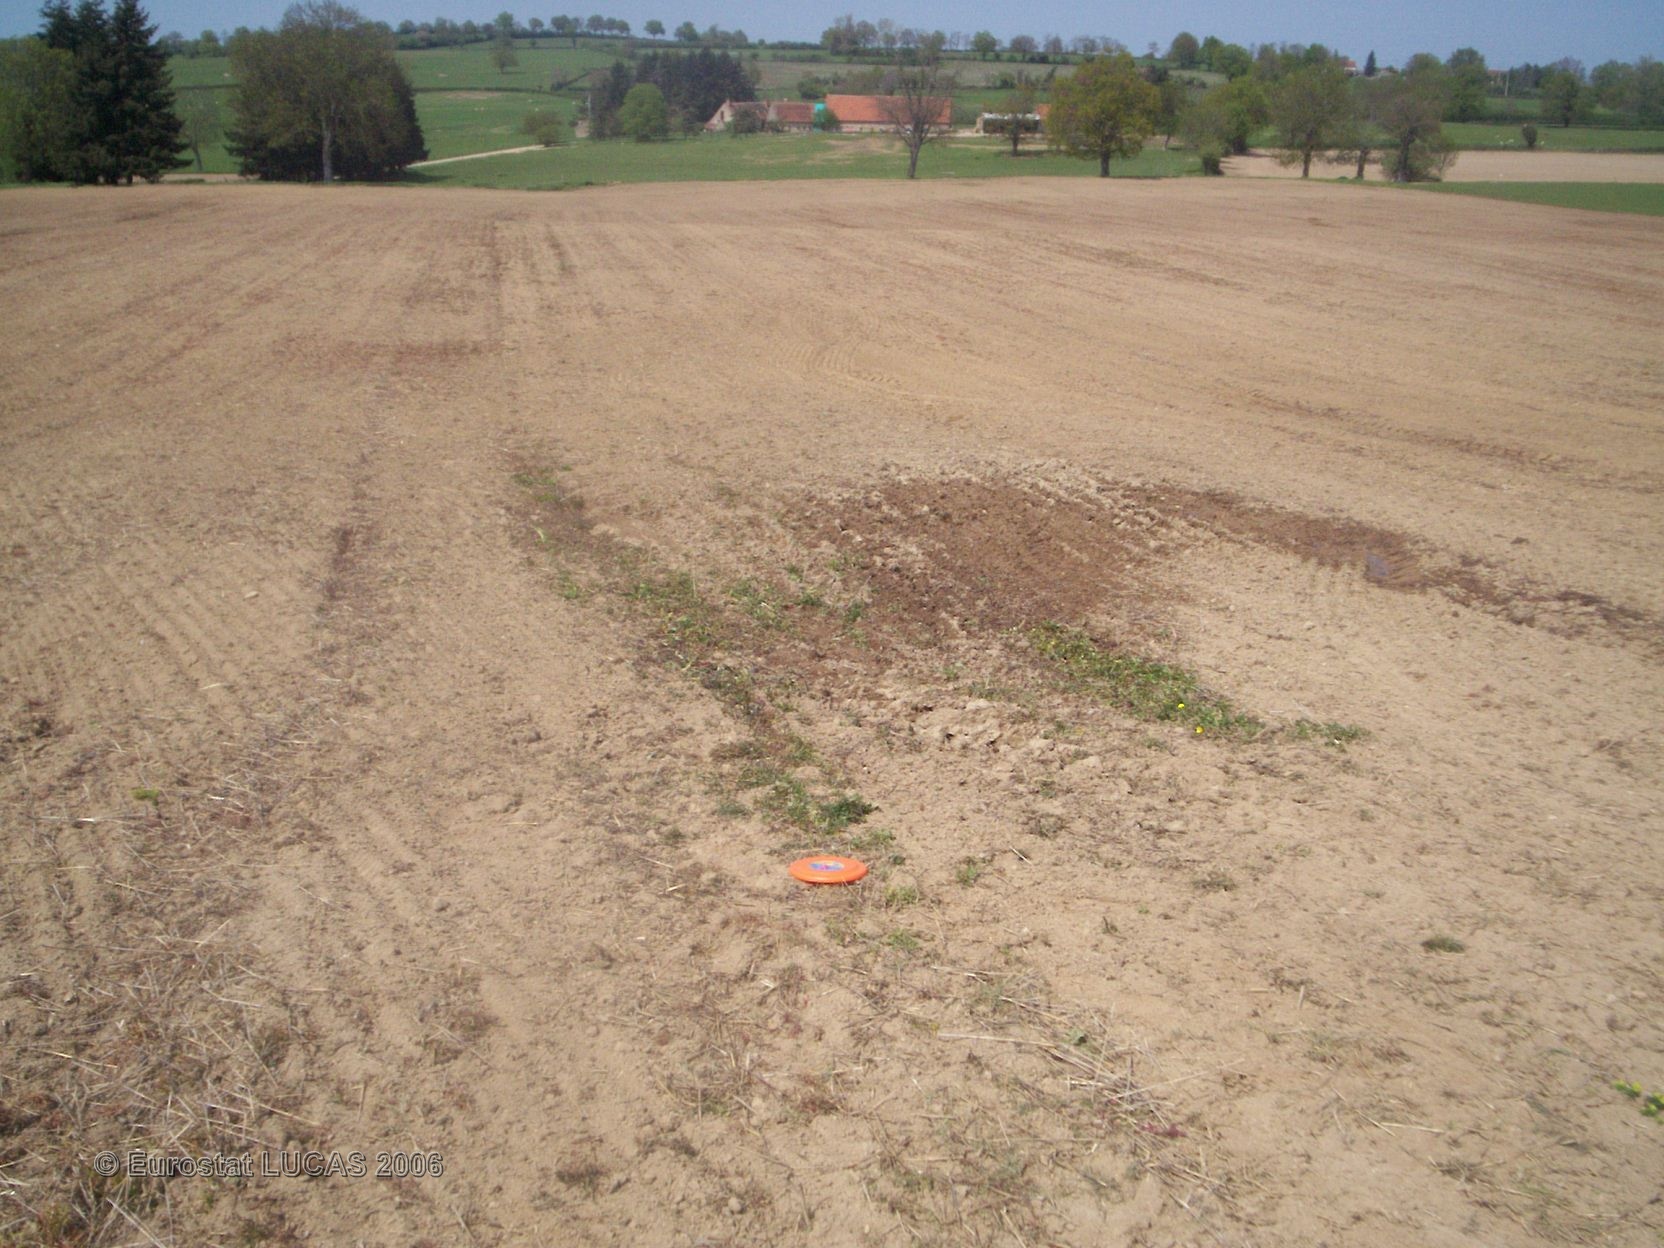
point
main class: Cropland
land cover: Barley
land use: Agriculture (excluding fallow land and kitchen gardens)
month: May
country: FR
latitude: 46.4576
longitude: 3.1623
